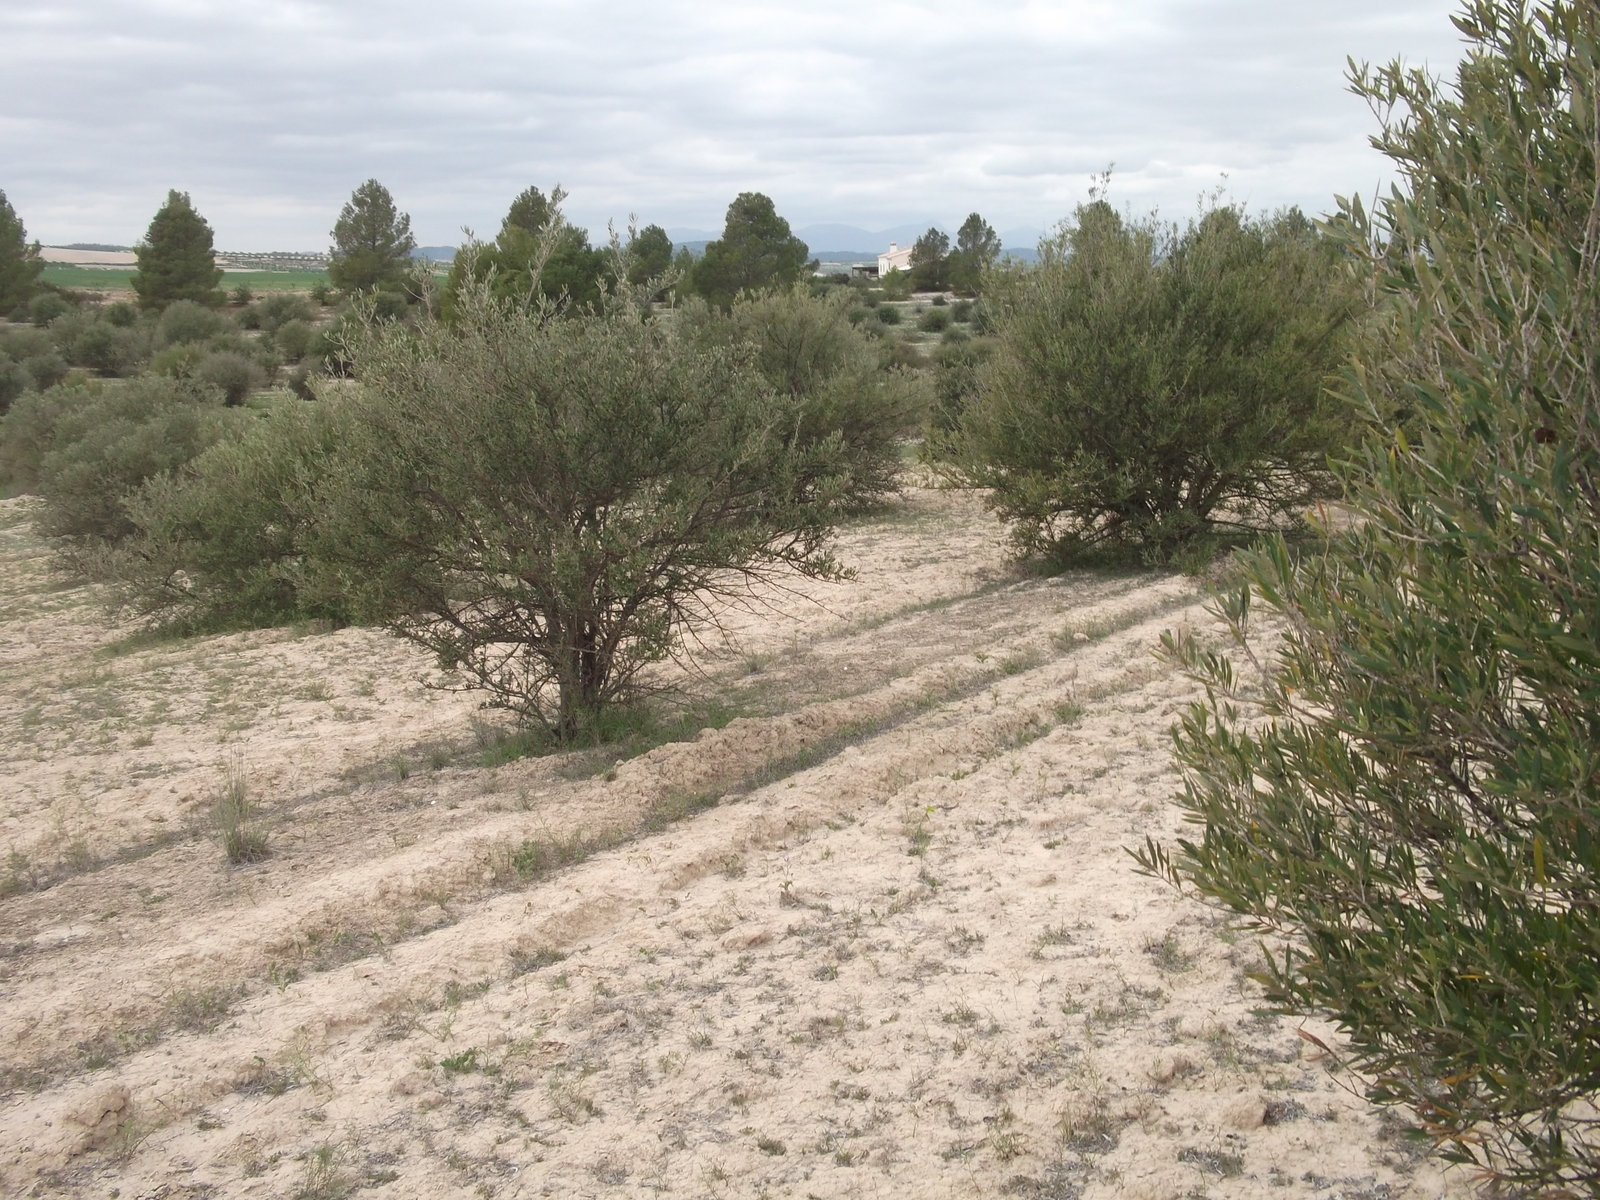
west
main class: Cropland
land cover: Olive groves
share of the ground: 25 - 50 %
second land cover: Other bare soil
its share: > 75 %
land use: Agriculture (excluding fallow land and kitchen gardens)
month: April
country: ES
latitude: 38.1548
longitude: -1.5714
